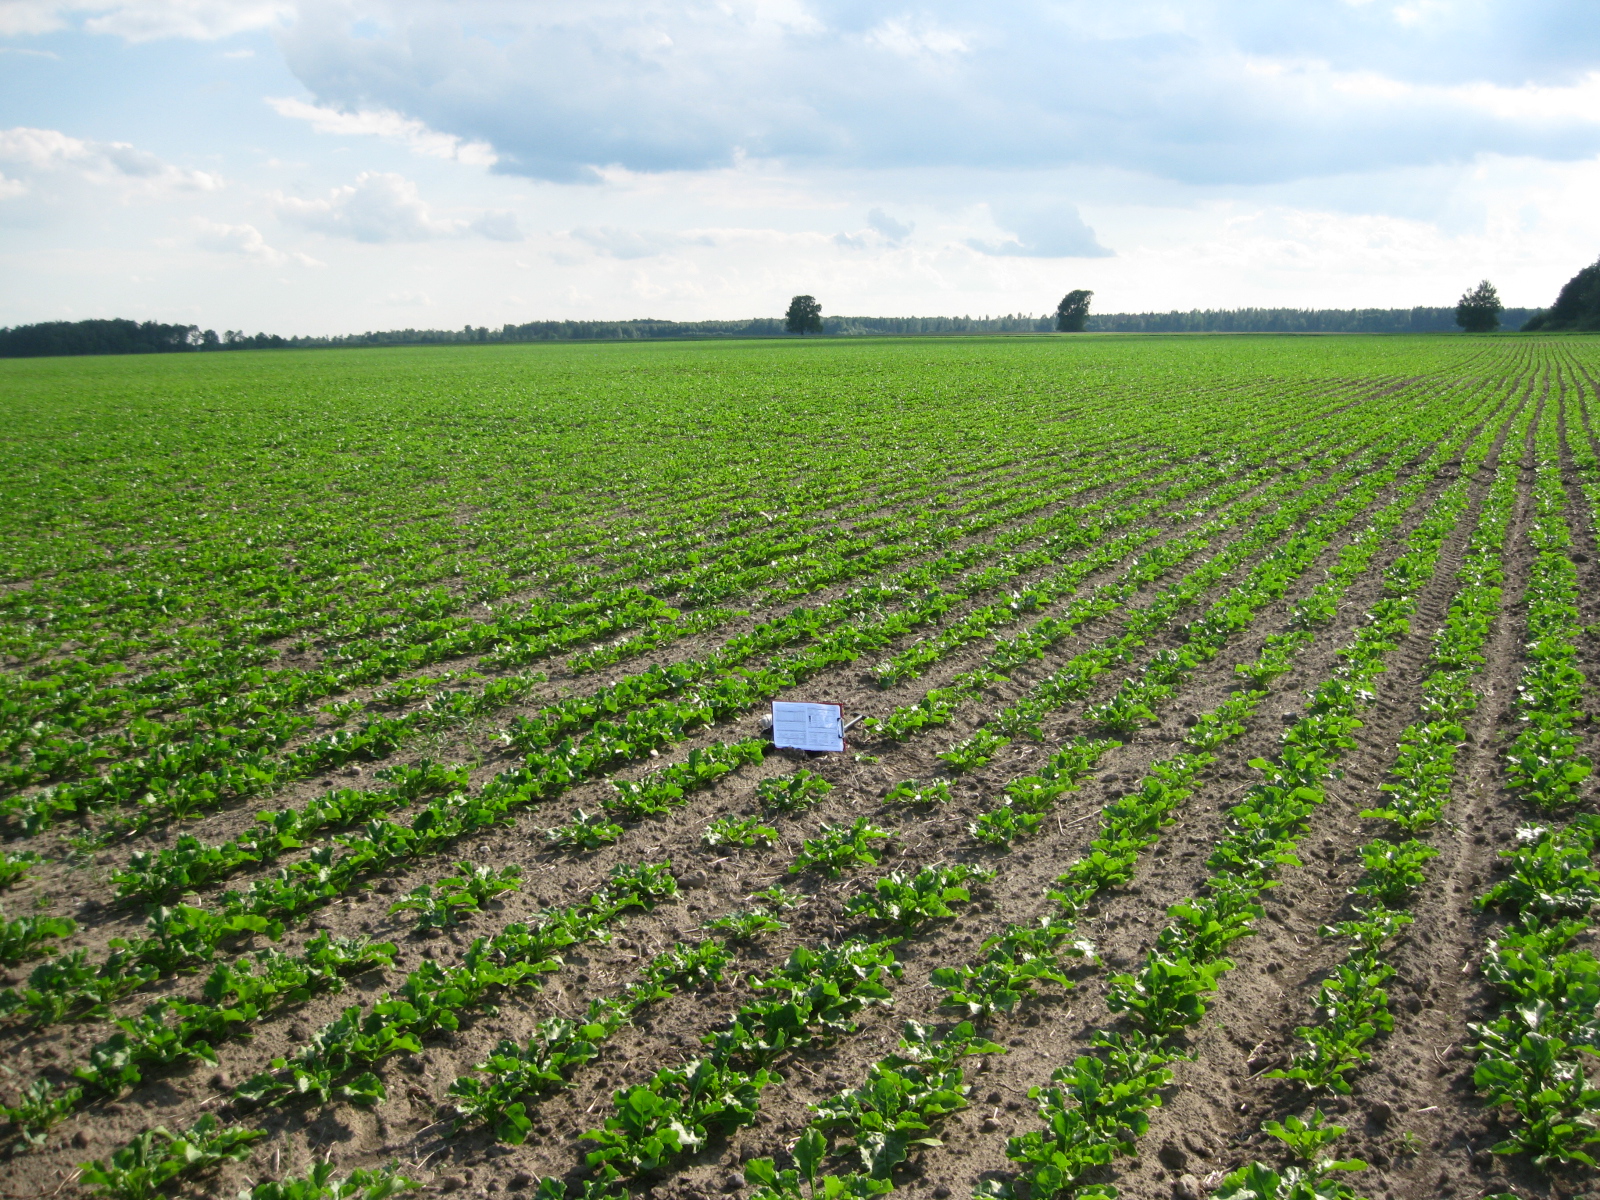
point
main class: Cropland
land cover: Sugar beet
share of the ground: 25 - 50 %
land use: Agriculture (excluding fallow land and kitchen gardens)
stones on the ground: < 10 %
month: June
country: LT
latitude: 55.5616
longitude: 23.8321
